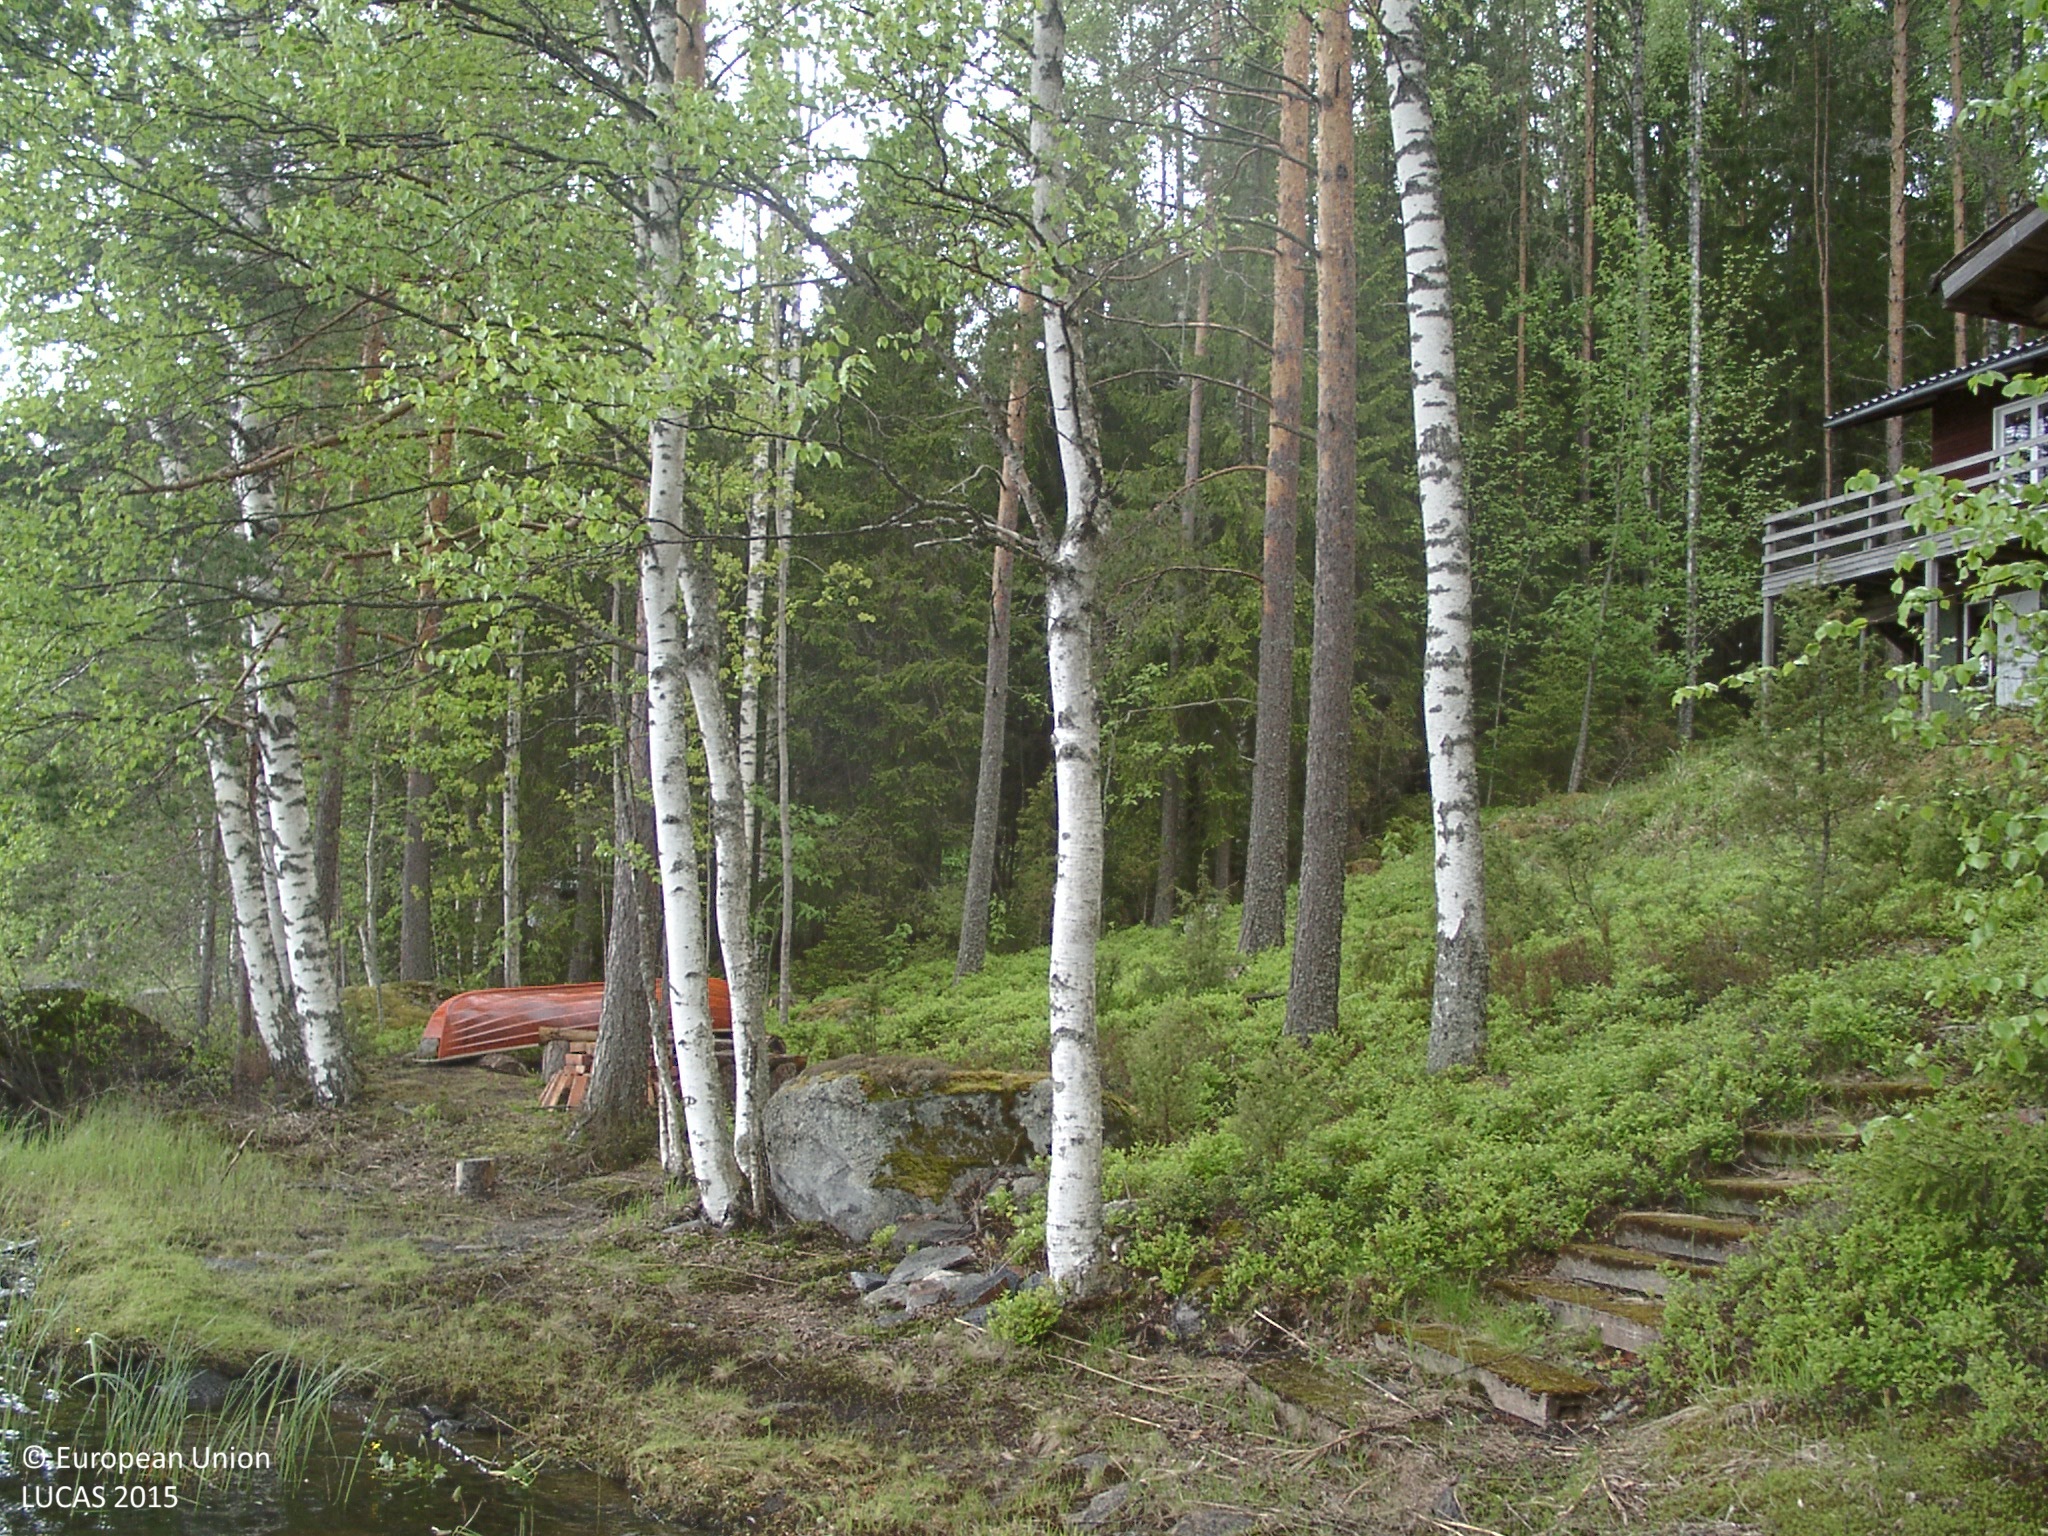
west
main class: Woodland
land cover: Other mixed woodland
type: boreal forest
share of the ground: 50 - 75 %
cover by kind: coniferous forest trees 35 %, shrubs 35 %, broadleaved forest trees 25 %, herbaceous plants 5 %
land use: Amenities, museums, leisure
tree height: > 5 m
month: June
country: FI
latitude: 62.2106
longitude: 25.4761
